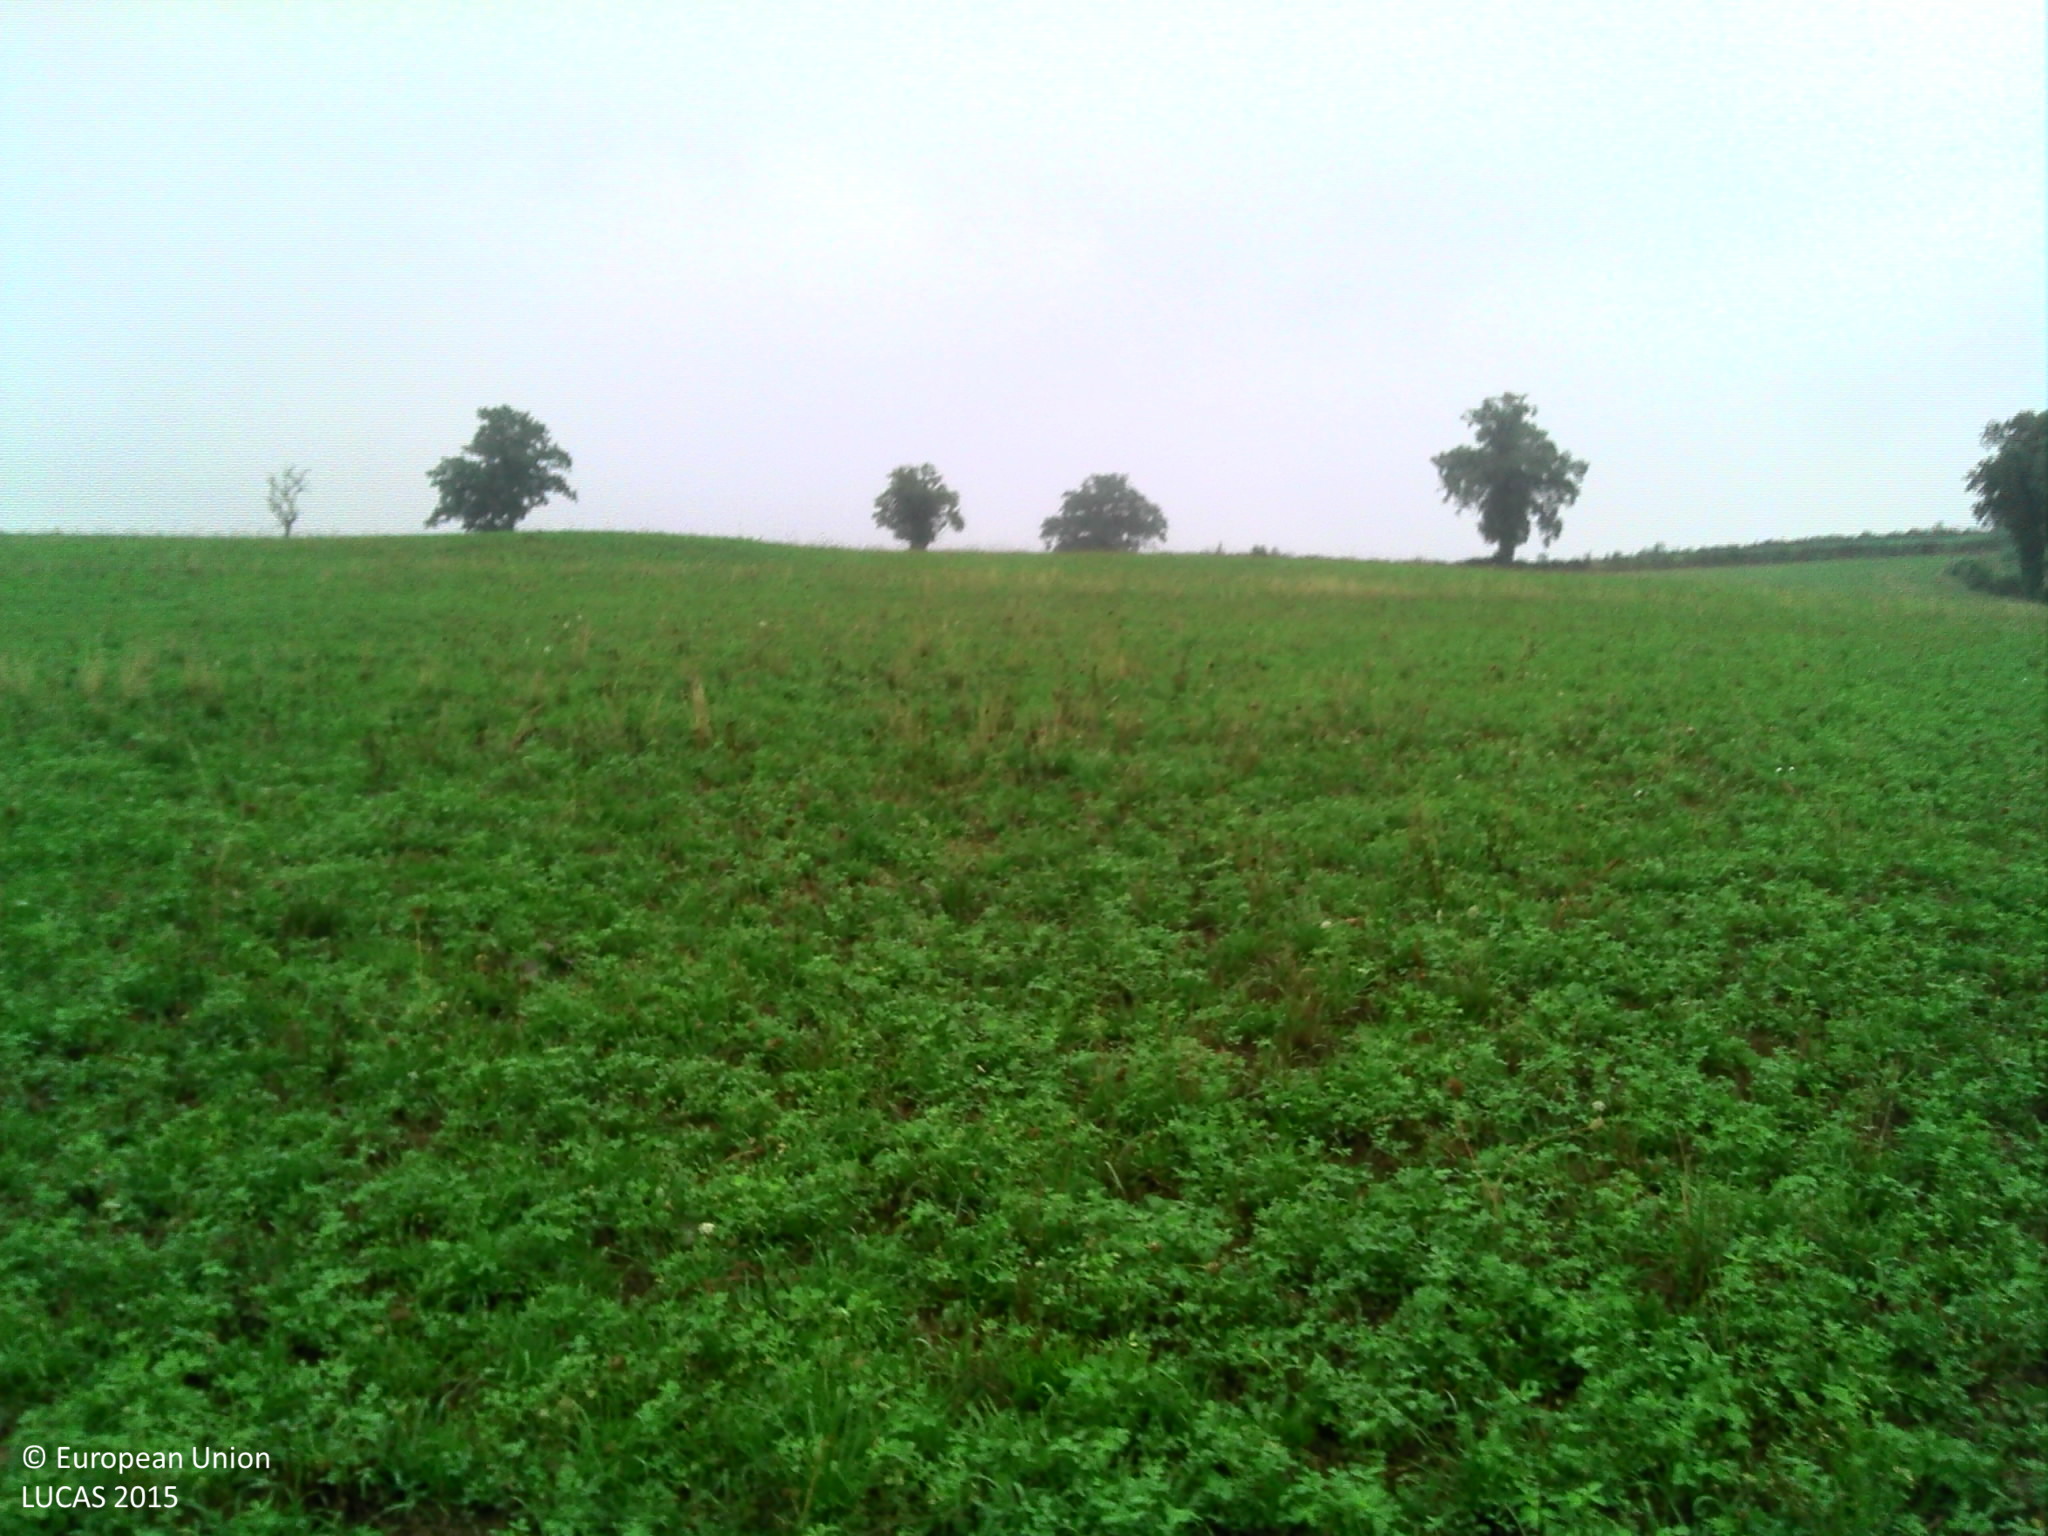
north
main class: Cropland
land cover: Lucerne
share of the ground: > 75 %
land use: Agriculture (excluding fallow land and kitchen gardens)
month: August
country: FR
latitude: 46.0754
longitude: 2.3282
